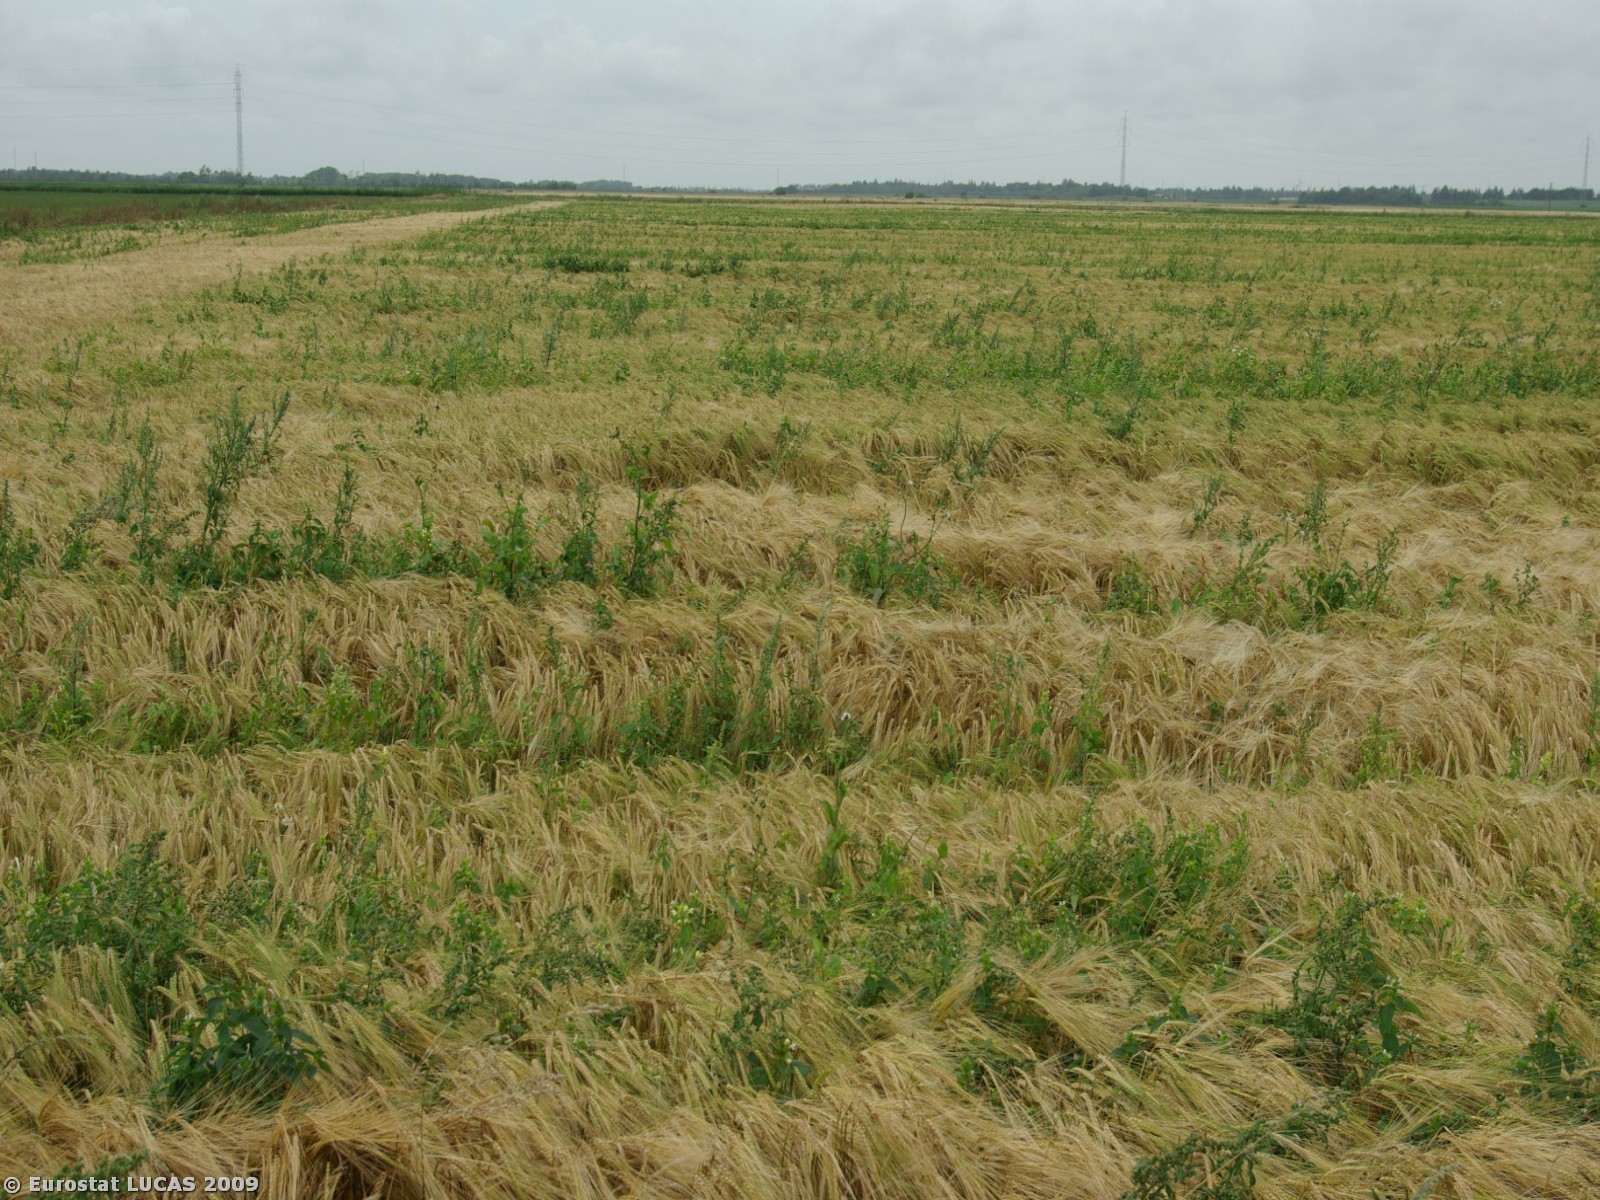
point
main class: Cropland
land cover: Barley
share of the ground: > 75 %
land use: Agriculture (excluding fallow land and kitchen gardens)
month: July
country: DK
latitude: 55.1041
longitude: 8.8567
